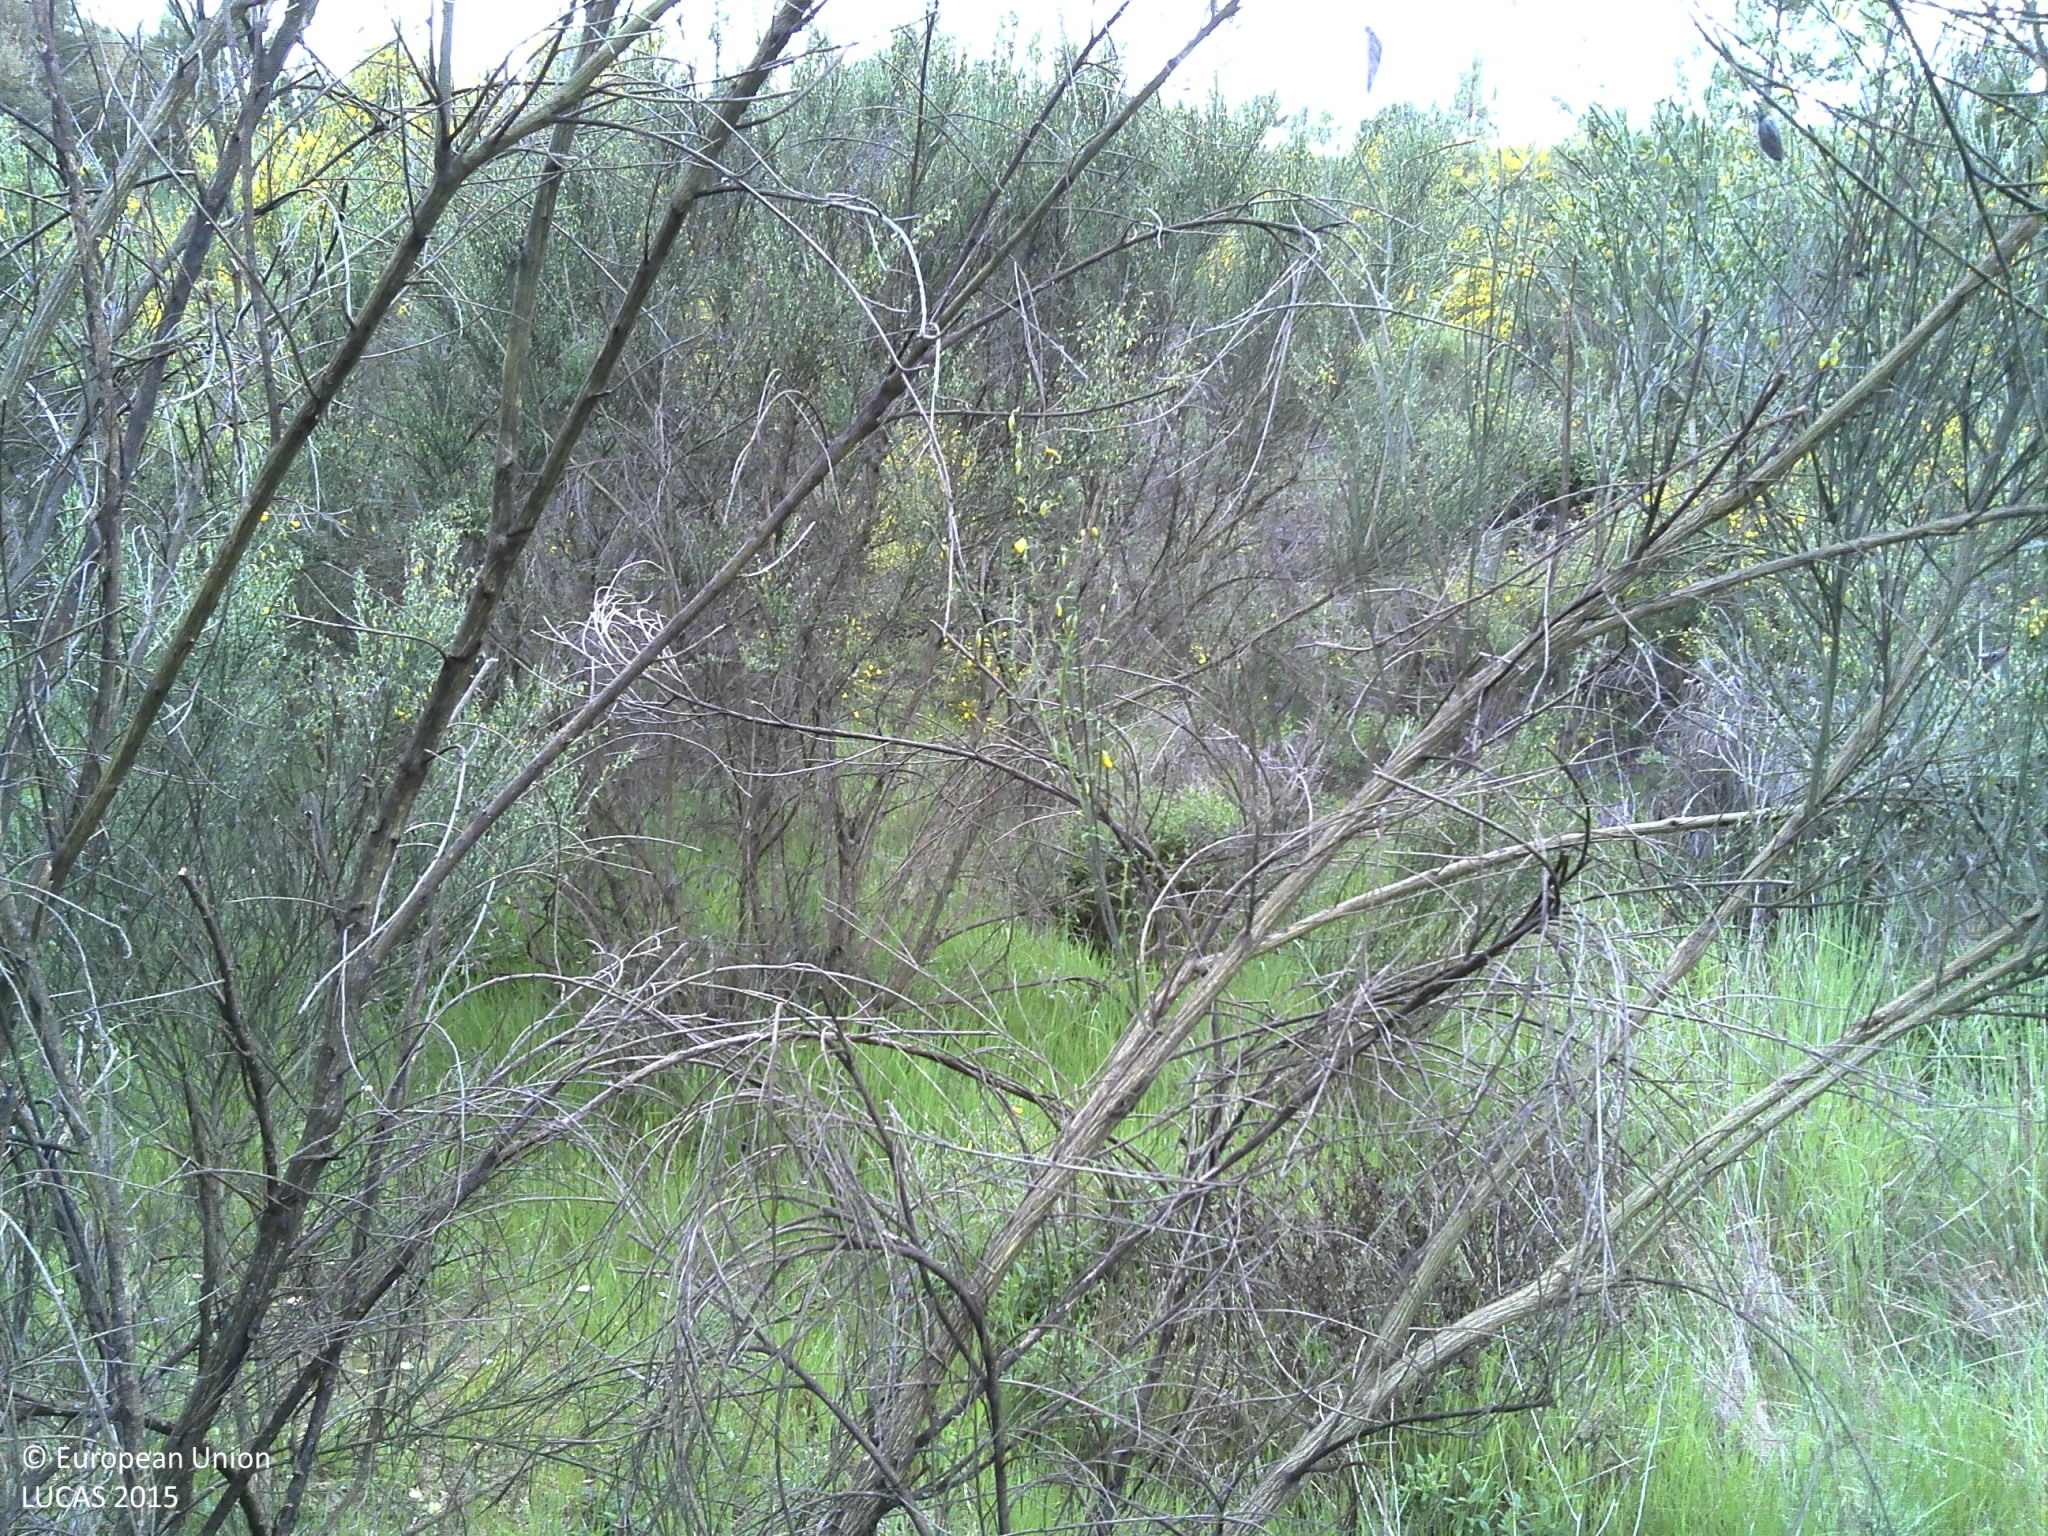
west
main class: Shrubland
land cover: Shrubland with sparse tree cover
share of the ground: > 75 %
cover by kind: shrubs 70 %, herbaceous plants 25 %, coniferous forest trees 5 %
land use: Semi-natural and natural areas not in use
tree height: > 5 m
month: May
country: PT
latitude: 41.7731
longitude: -7.1202
